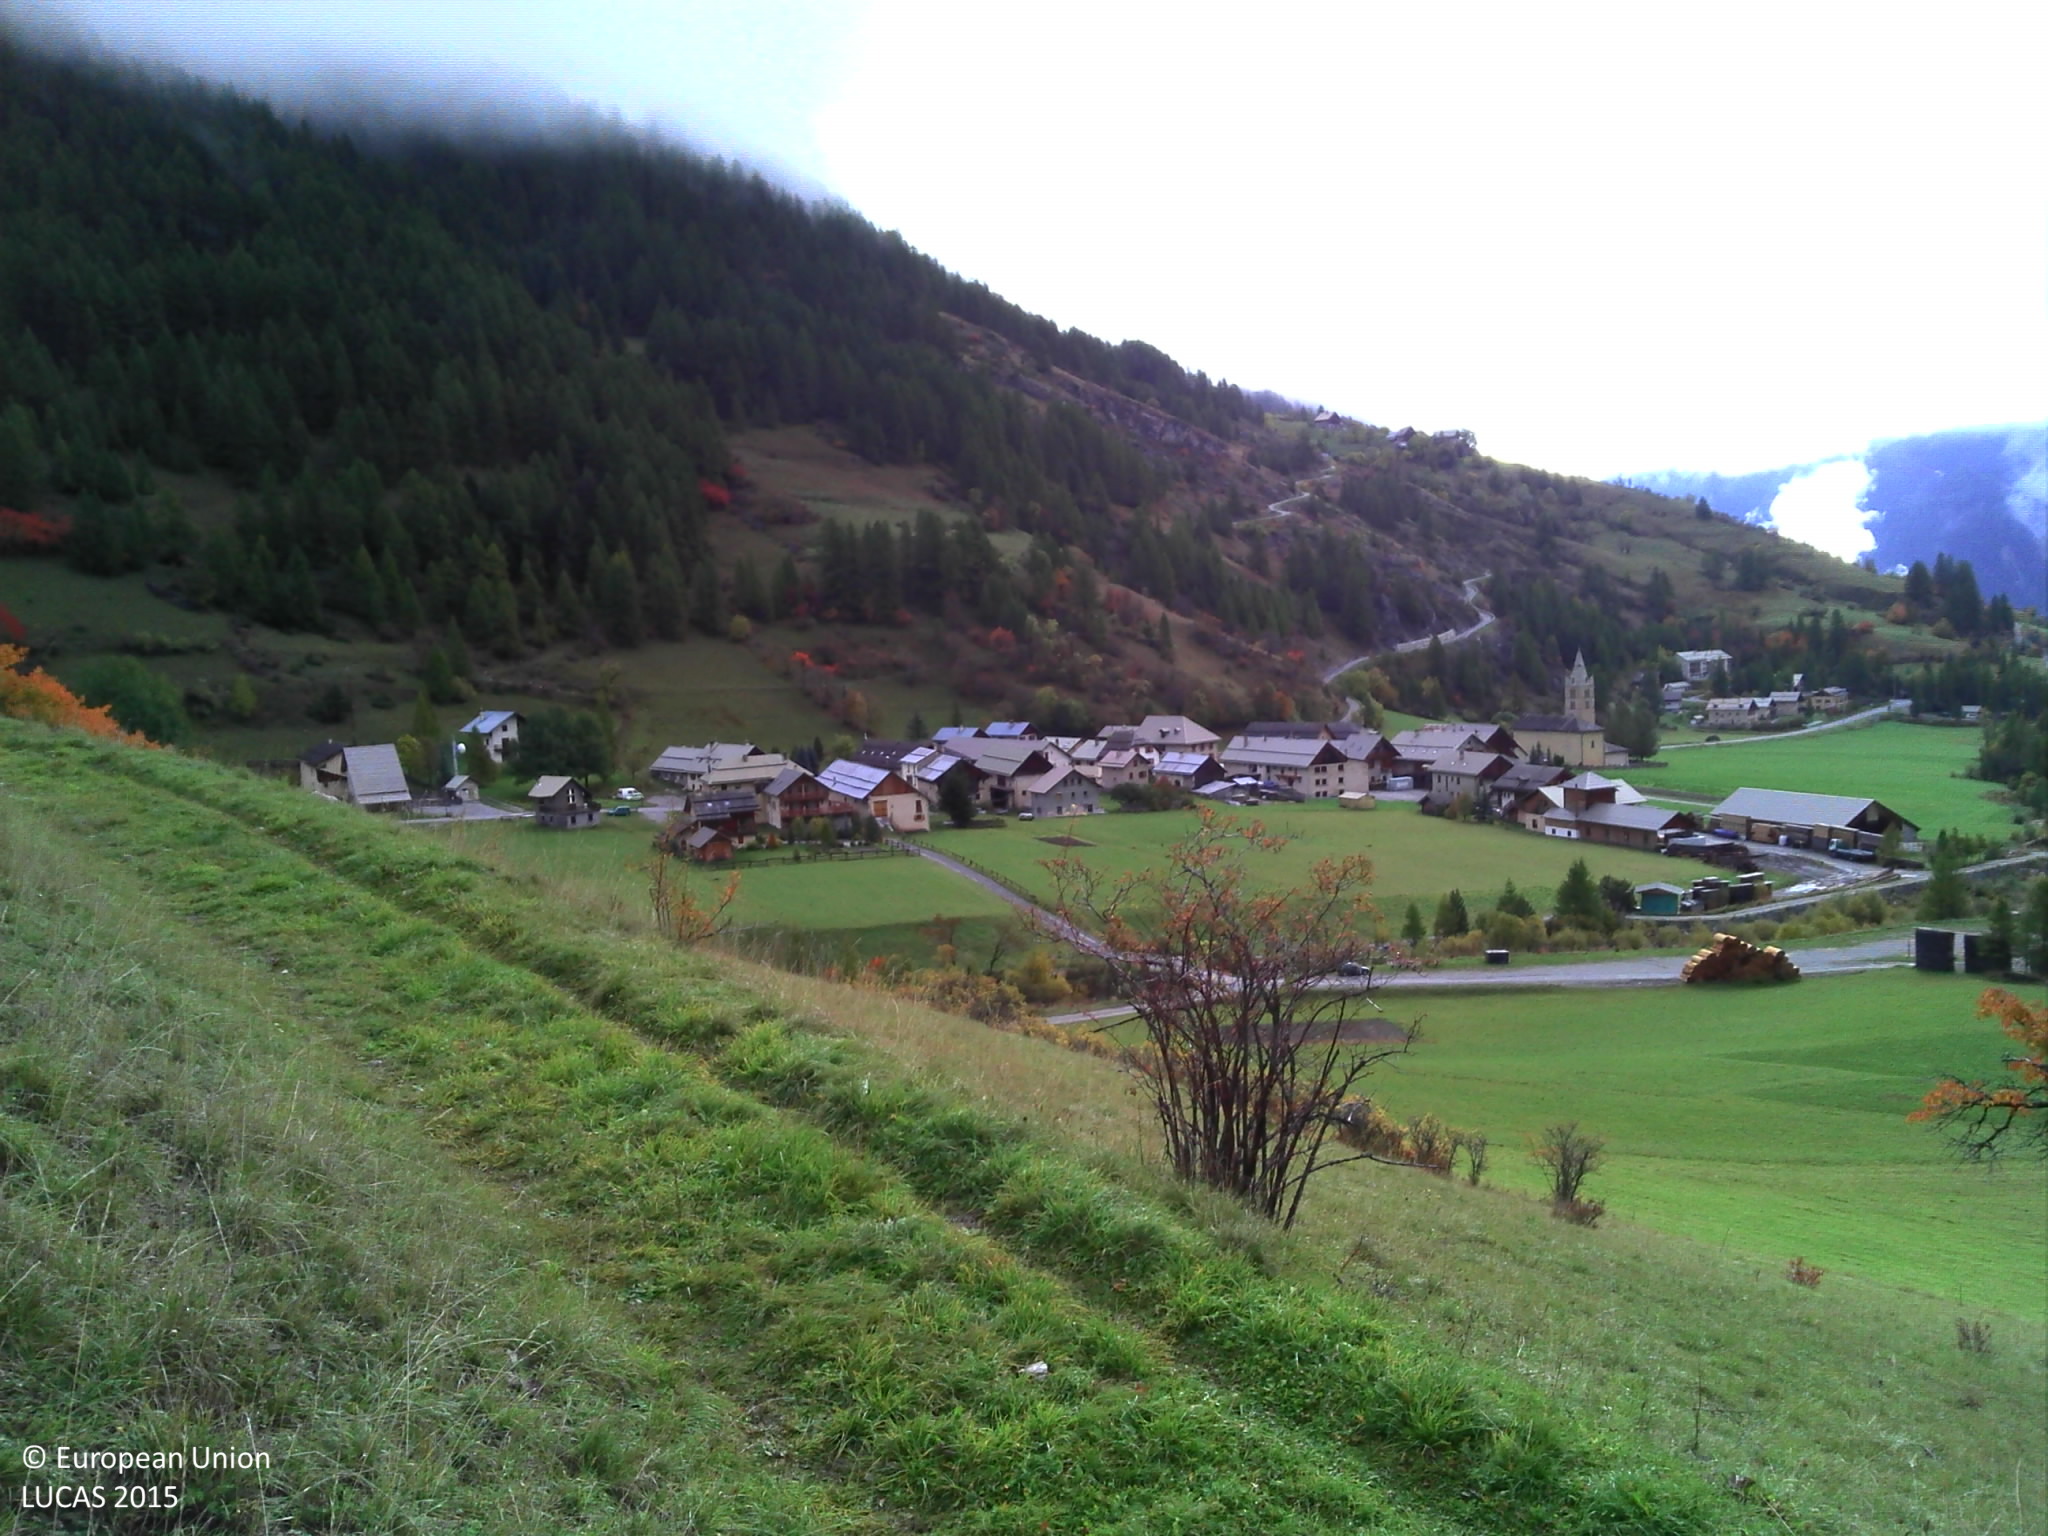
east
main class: Grassland
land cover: Grassland without tree/shrub cover
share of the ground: > 75 %
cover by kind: herbaceous plants 90 %, shrubs 5 %, consolidated bare surface 5 %
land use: Agriculture (excluding fallow land and kitchen gardens)
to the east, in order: Grassland without tree/shrub cover; Tracks; Grassland without tree/shrub cover; Managed hedges; Ditches and canals; Pine dominated mixed woodland; Grassland without tree/shrub cover; Managed hedges; Tracks; Pine dominated mixed woodland; Inland fresh running water; Shrubland with sparse tree cover; Pine dominated coniferous woodland; Grassland without tree/shrub cover
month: October
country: FR
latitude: 44.7684
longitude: 6.7332
